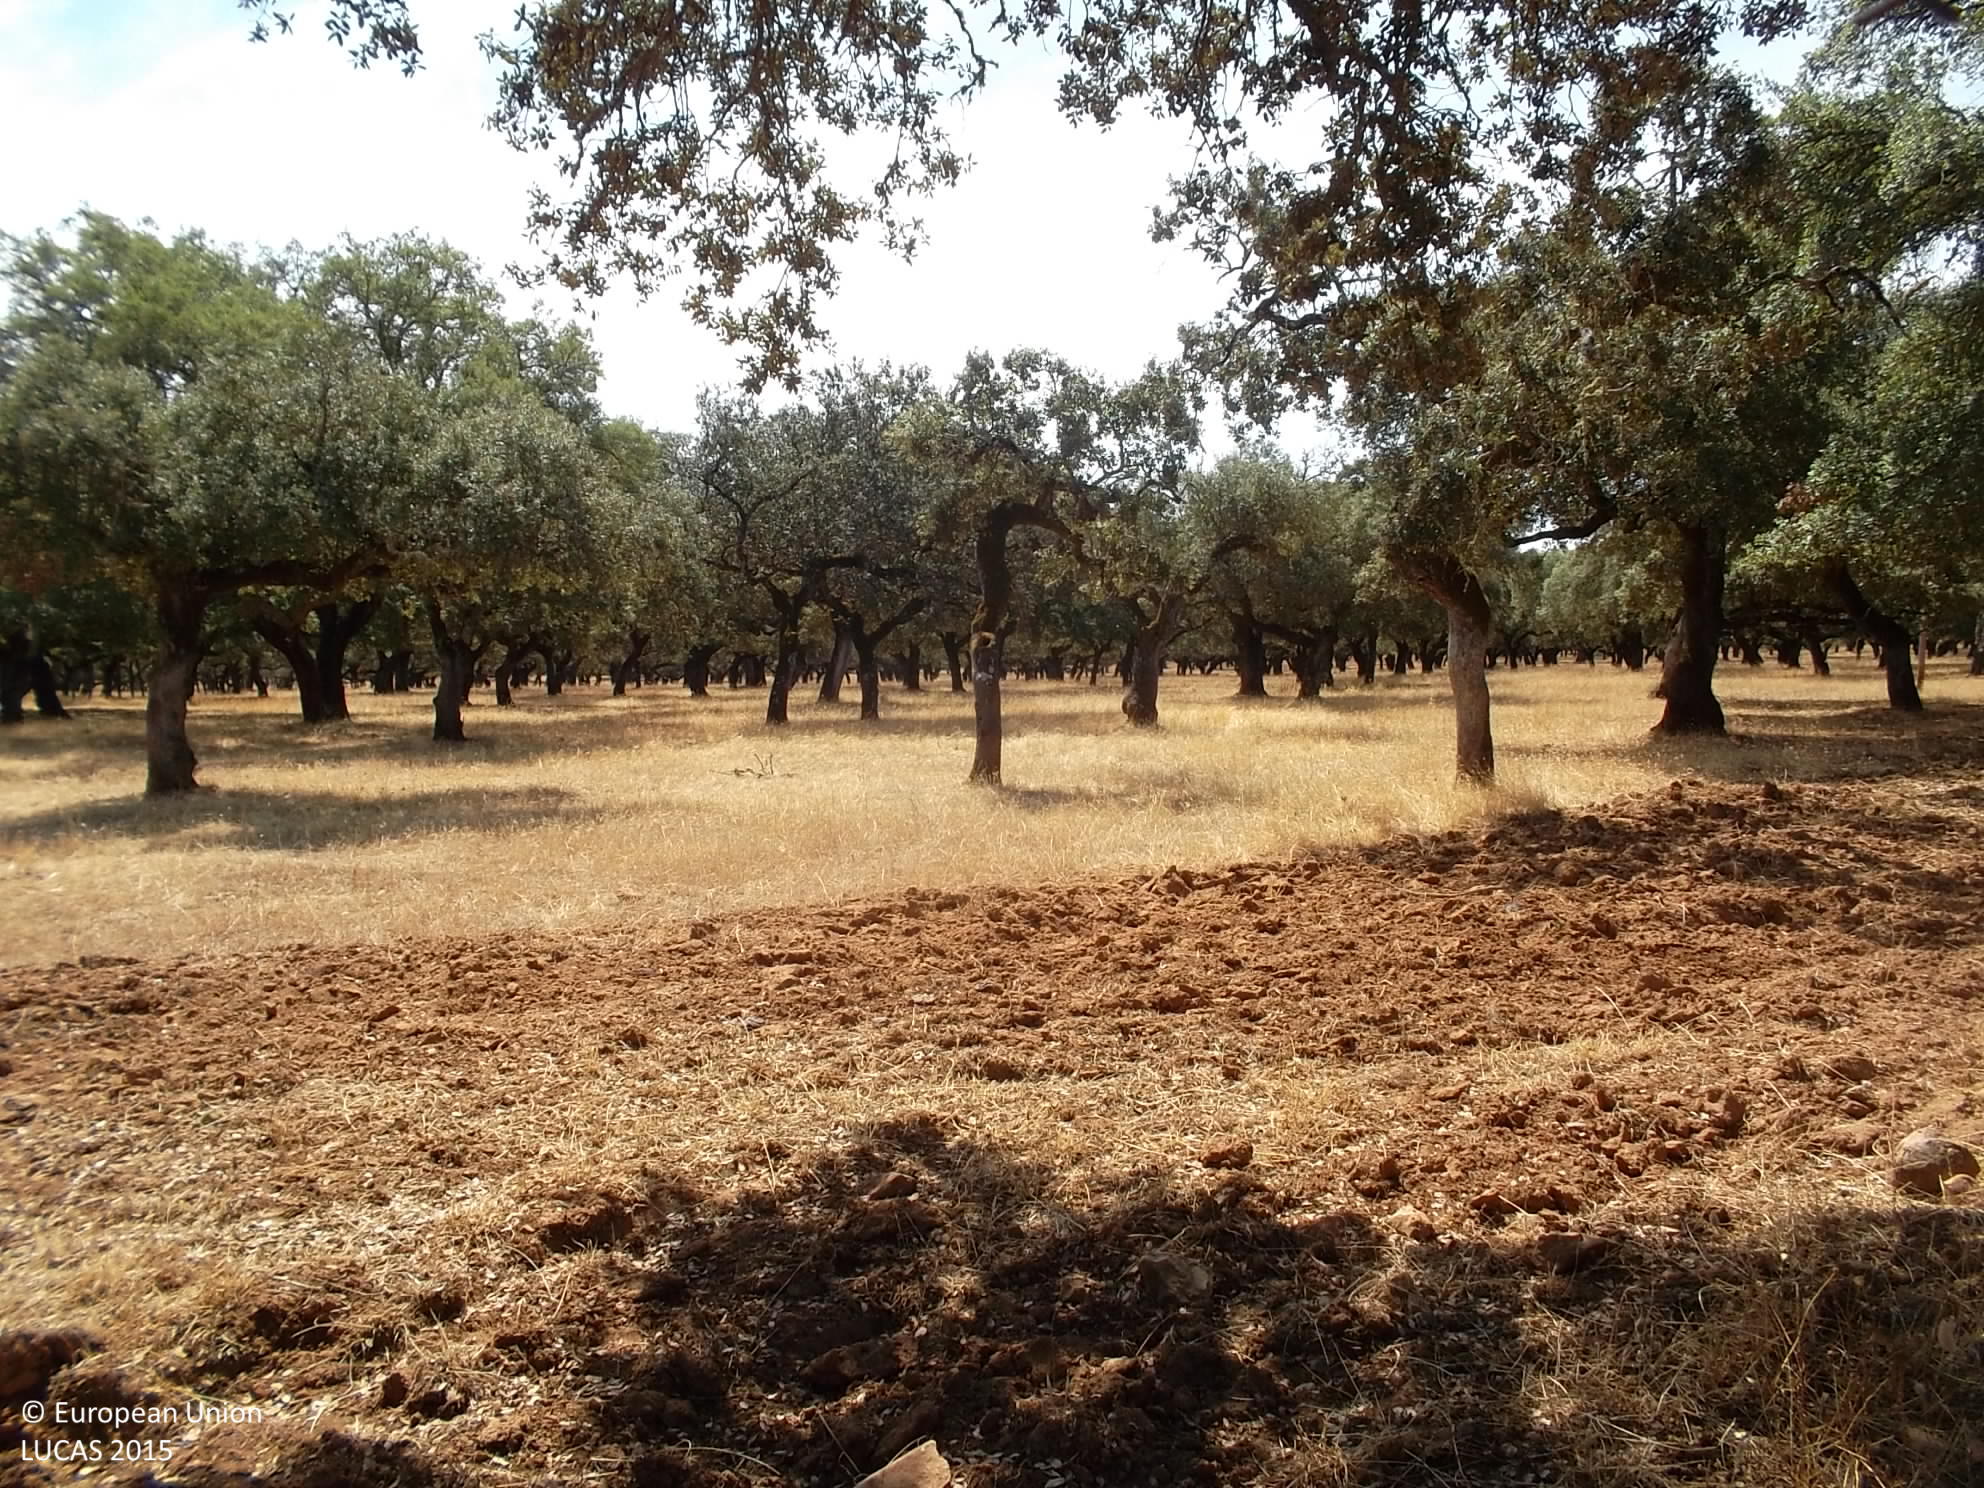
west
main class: Woodland
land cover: Broadleaved woodland
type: broadleaved evergreen forest
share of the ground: 50 - 75 %
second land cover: Grassland without tree/shrub cover
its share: > 75 %
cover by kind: broadleaved forest trees 50 %, herbaceous plants 50 %
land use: Forestry
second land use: Agriculture (excluding fallow land and kitchen gardens)
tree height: > 5 m
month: August
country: ES
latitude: 38.2074
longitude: -6.6444
